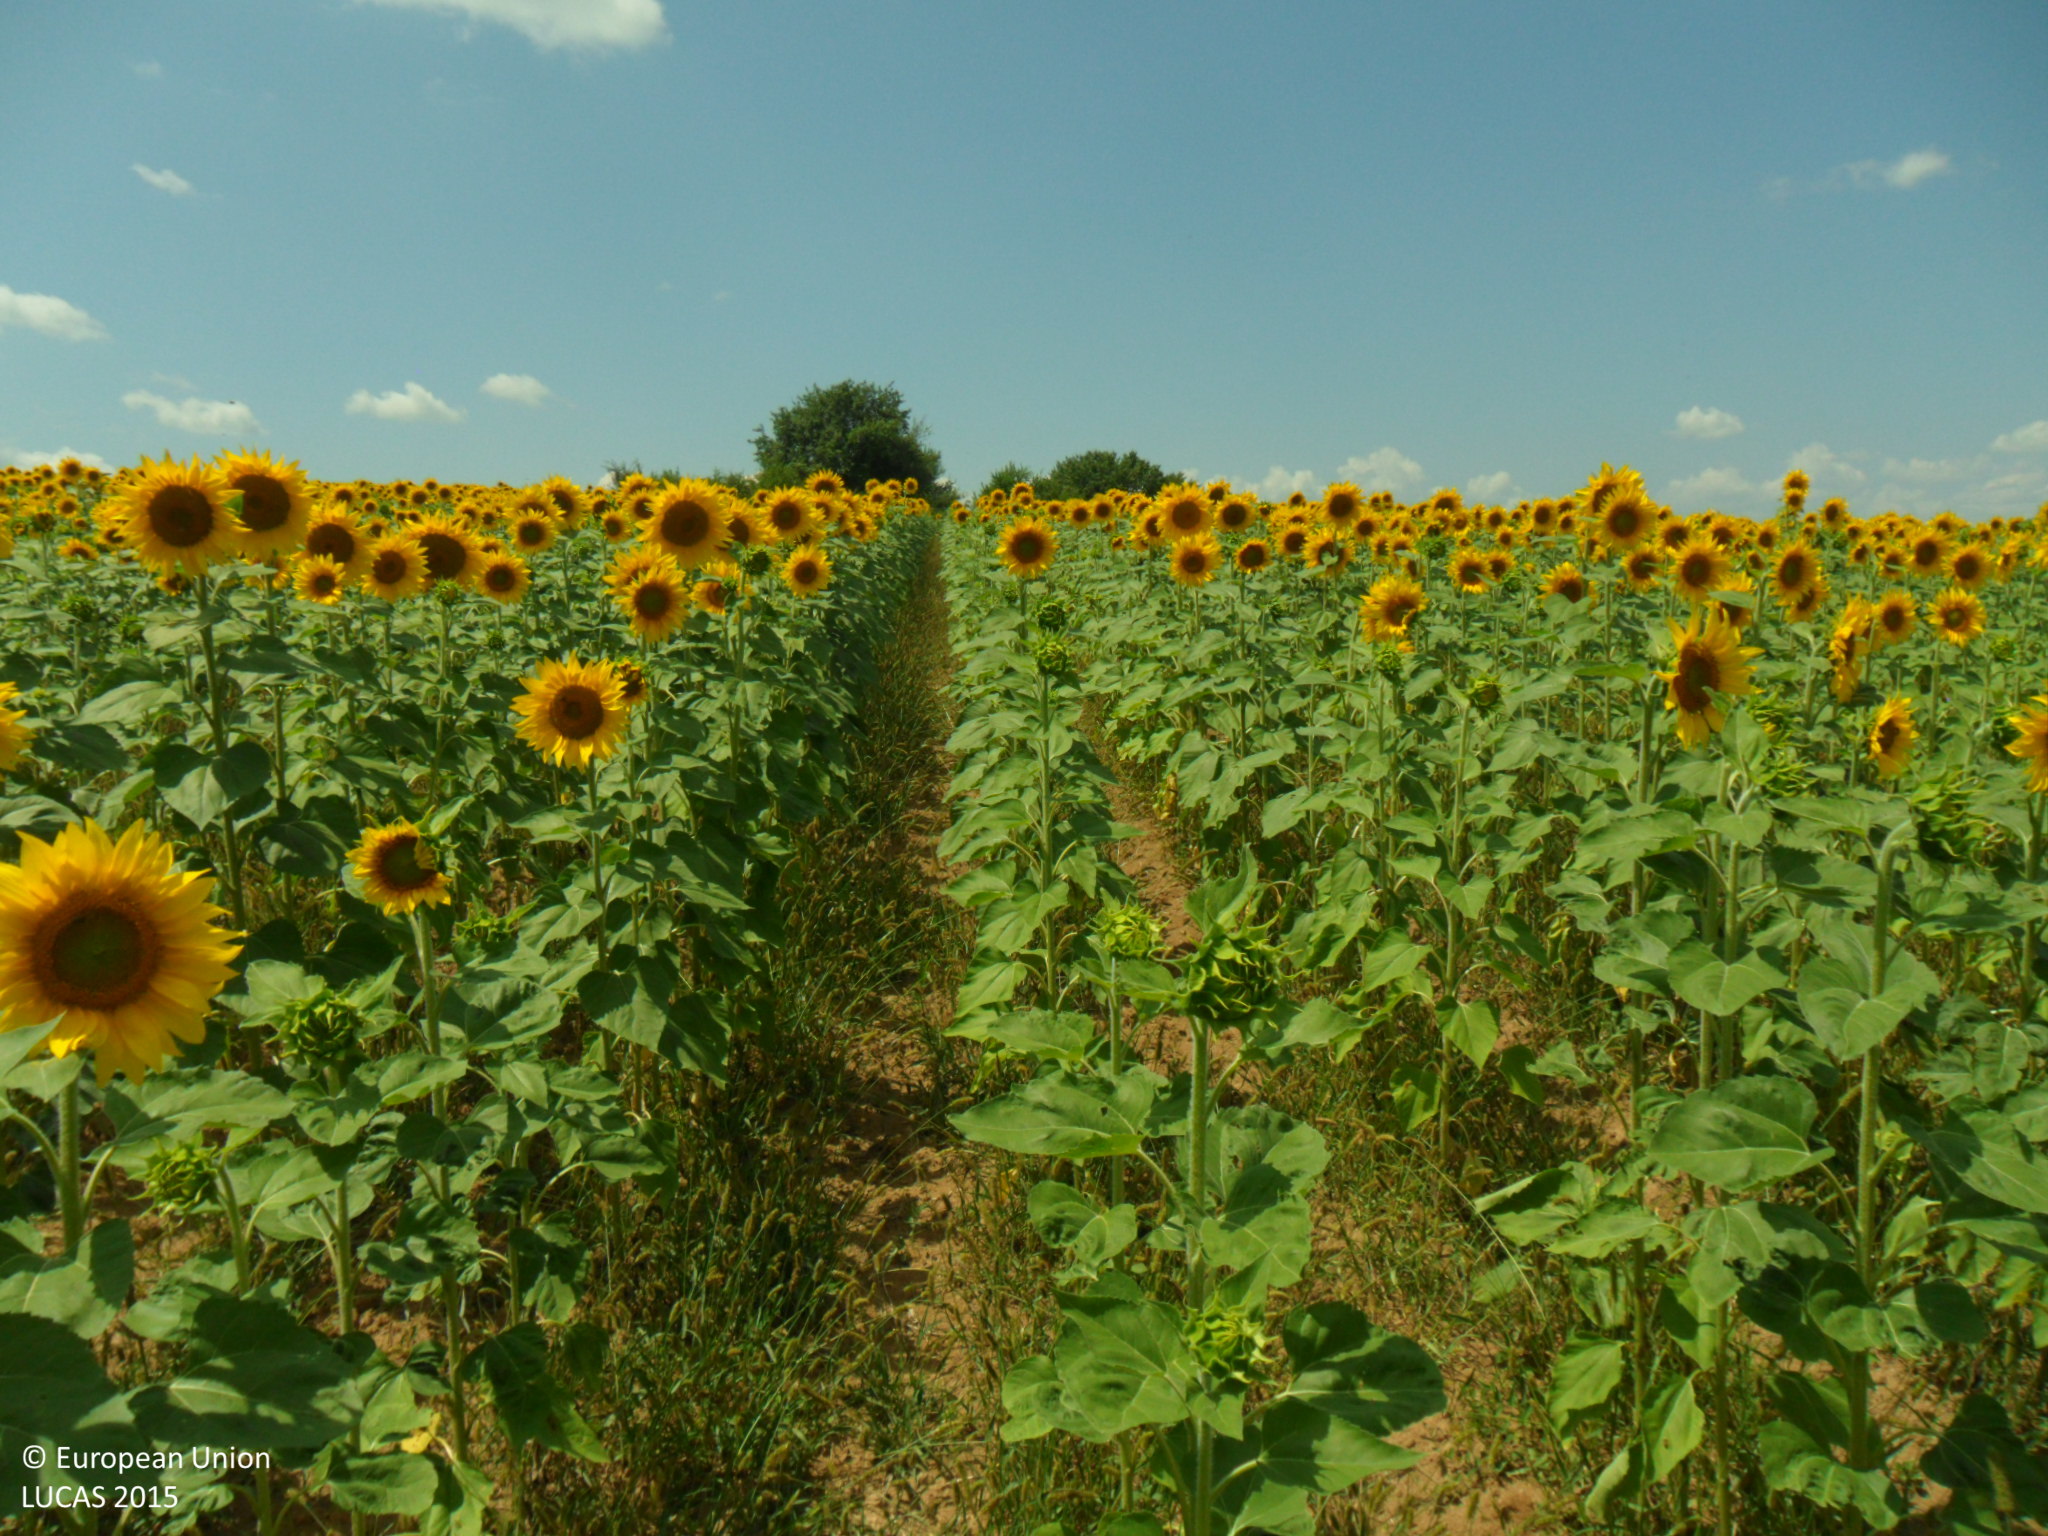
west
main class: Cropland
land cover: Sunflower
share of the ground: > 75 %
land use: Agriculture (excluding fallow land and kitchen gardens)
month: July
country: BG
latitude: 43.0431
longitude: 27.0152
